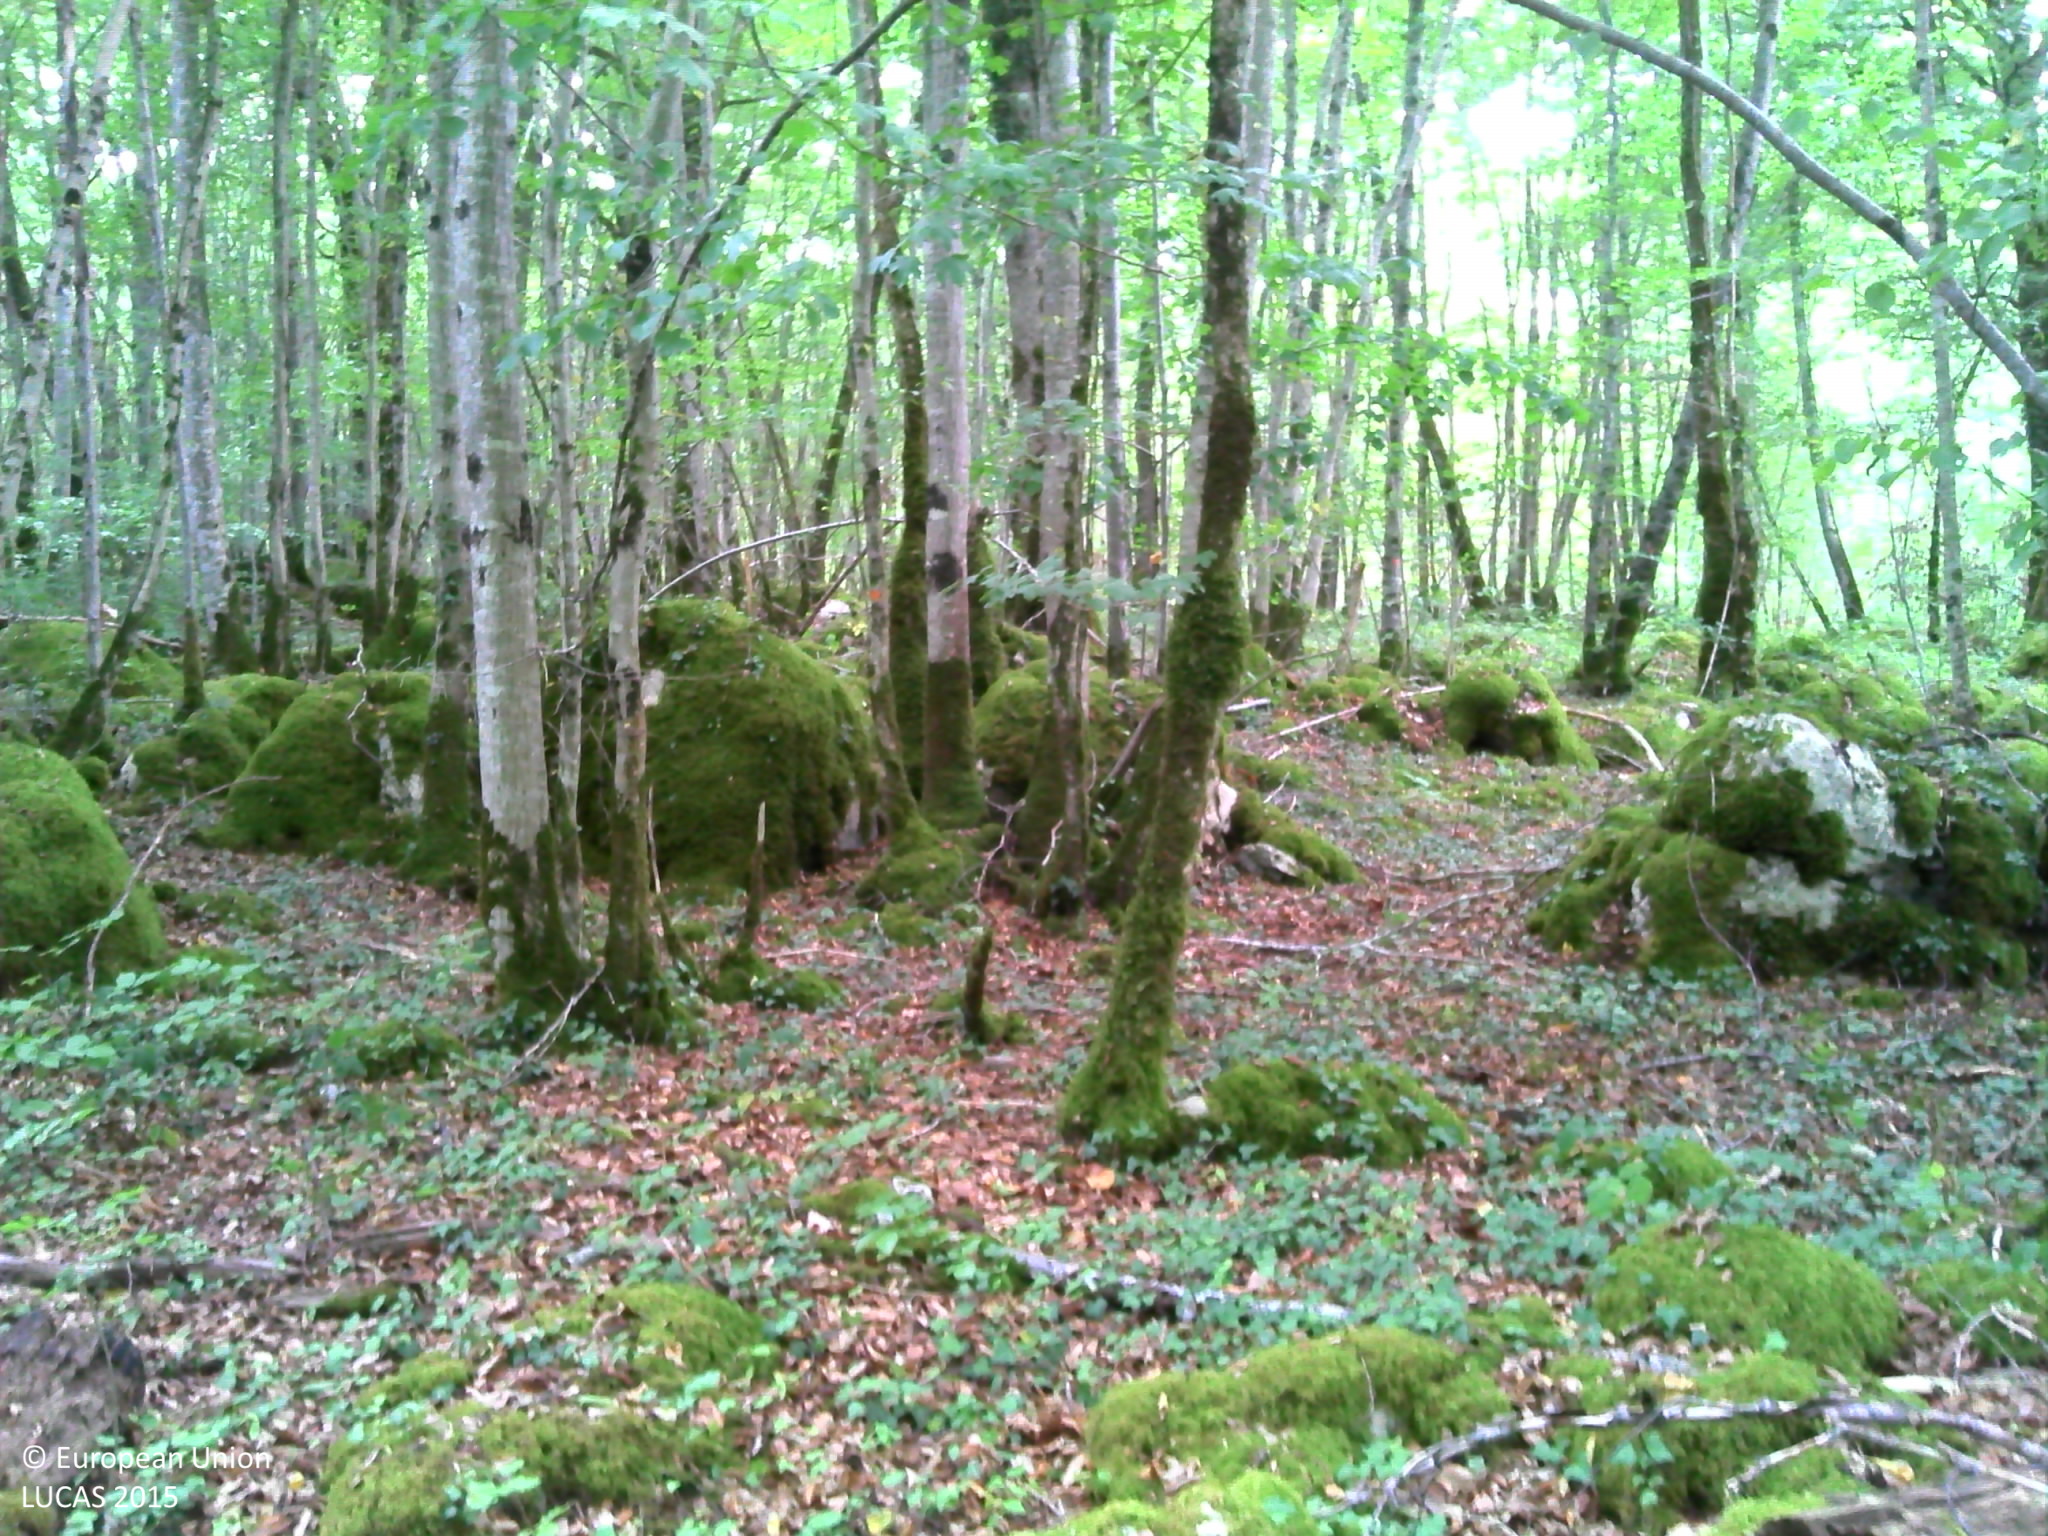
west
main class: Woodland
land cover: Broadleaved woodland
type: beech forest
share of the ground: > 75 %
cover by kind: broadleaved forest trees 90 %, herbaceous plants 5 %, lichens and mosses 5 %
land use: Forestry
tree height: > 5 m
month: August
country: FR
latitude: 47.7625
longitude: 4.8895
